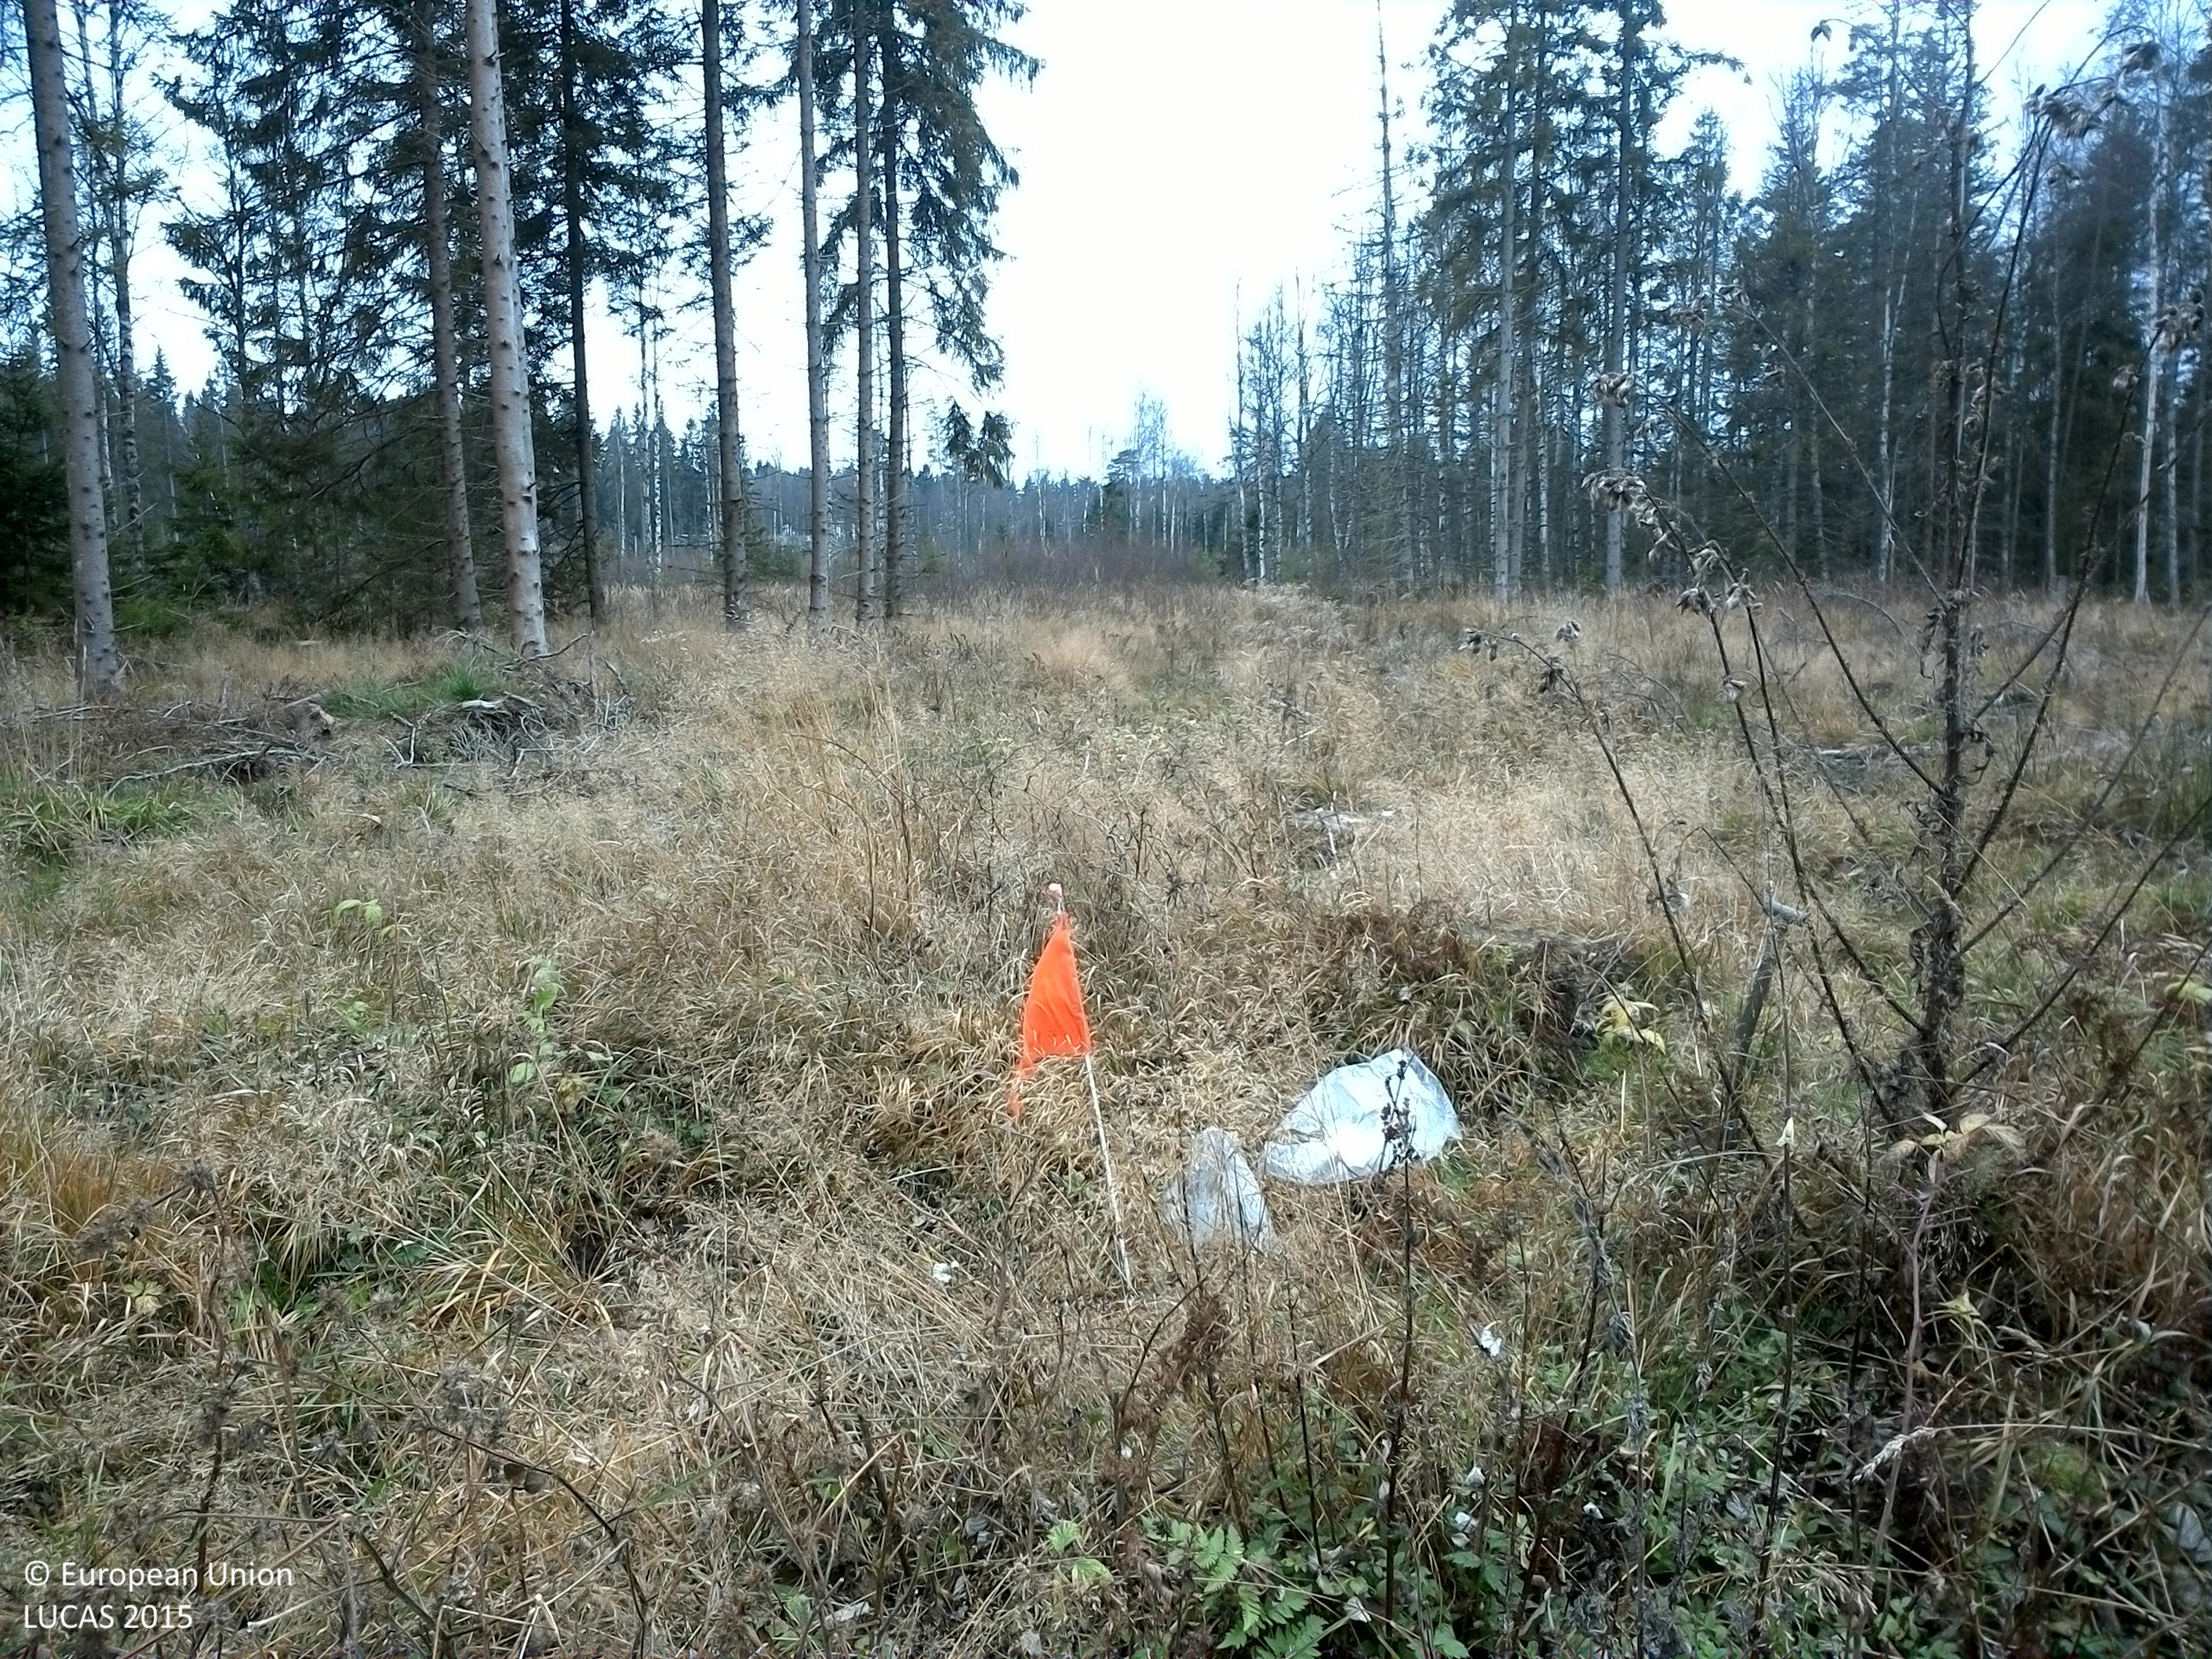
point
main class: Grassland
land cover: Grassland with sparse tree/shrub cover
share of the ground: > 75 %
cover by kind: herbaceous plants 90 %, coniferous forest trees 5 %, shrubs 5 %
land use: Forestry
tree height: < 5 m
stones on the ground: < 10 %
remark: Clear cut
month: November
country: SE
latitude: 57.8289
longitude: 14.7606
